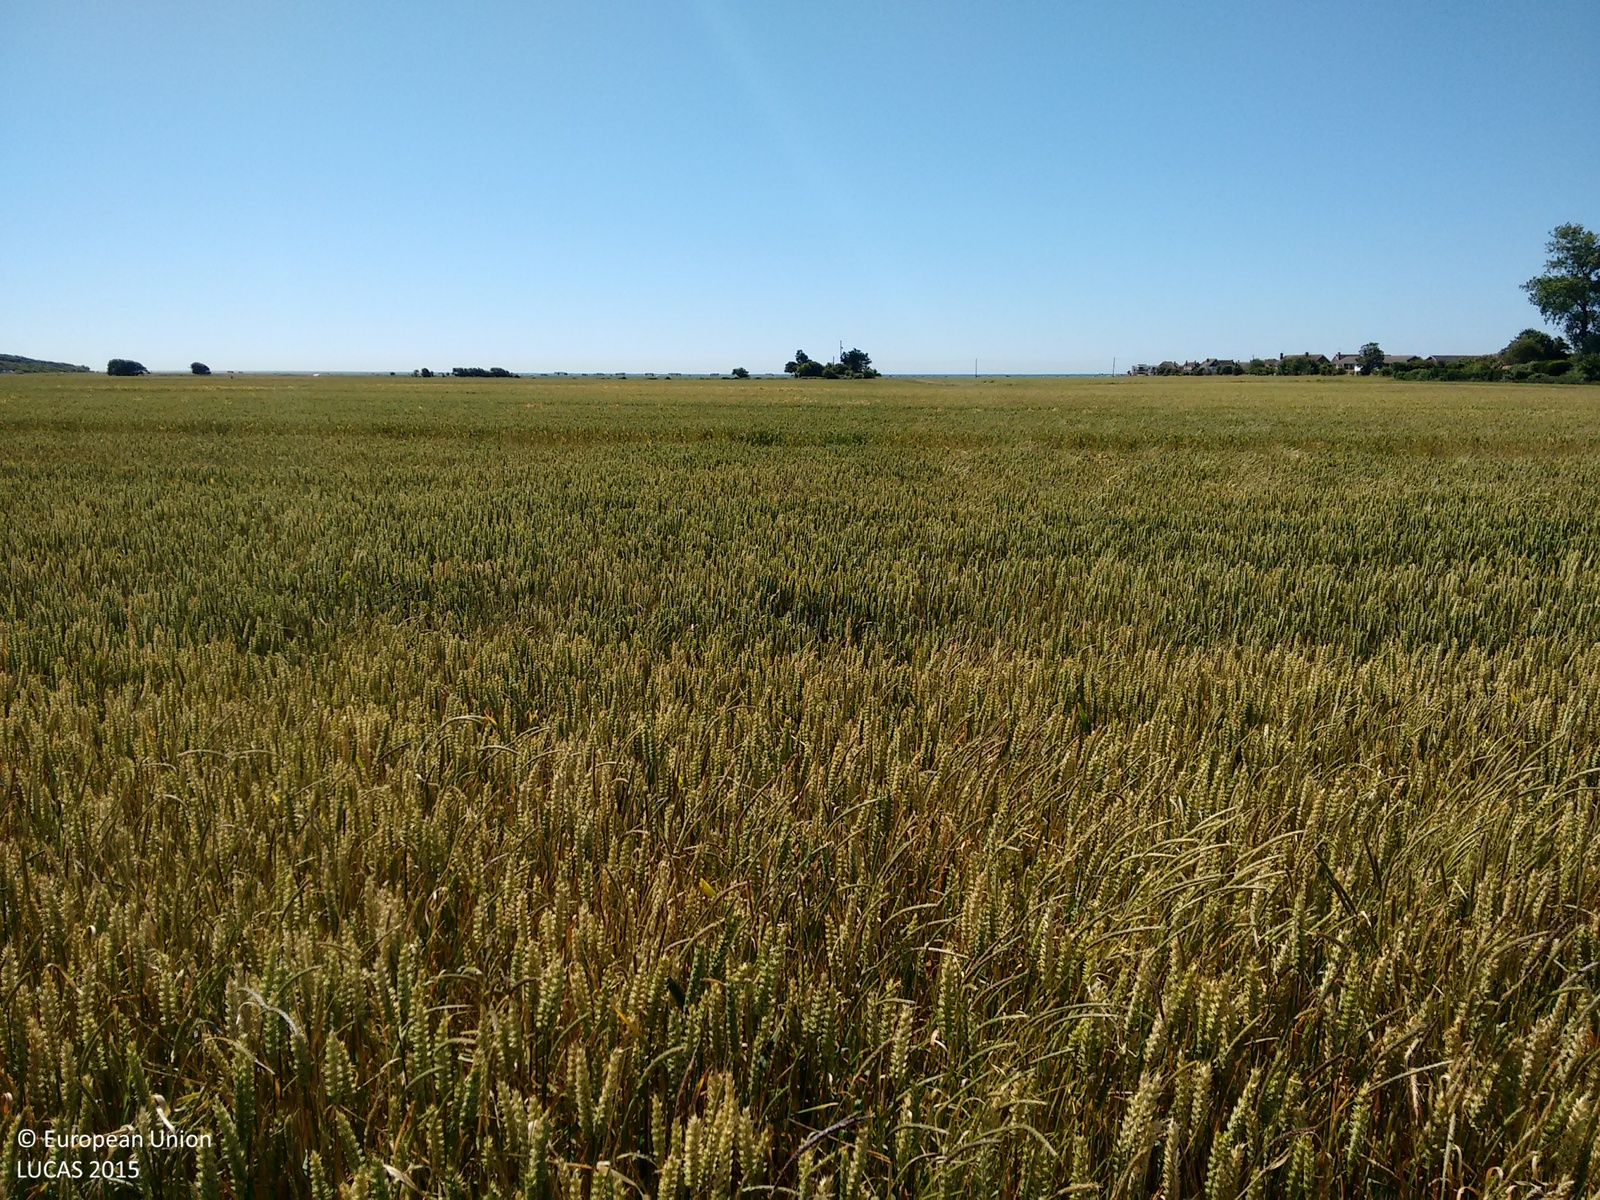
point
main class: Cropland
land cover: Common wheat
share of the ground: > 75 %
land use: Agriculture (excluding fallow land and kitchen gardens)
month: June
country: GB
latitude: 50.8098
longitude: -0.4400
